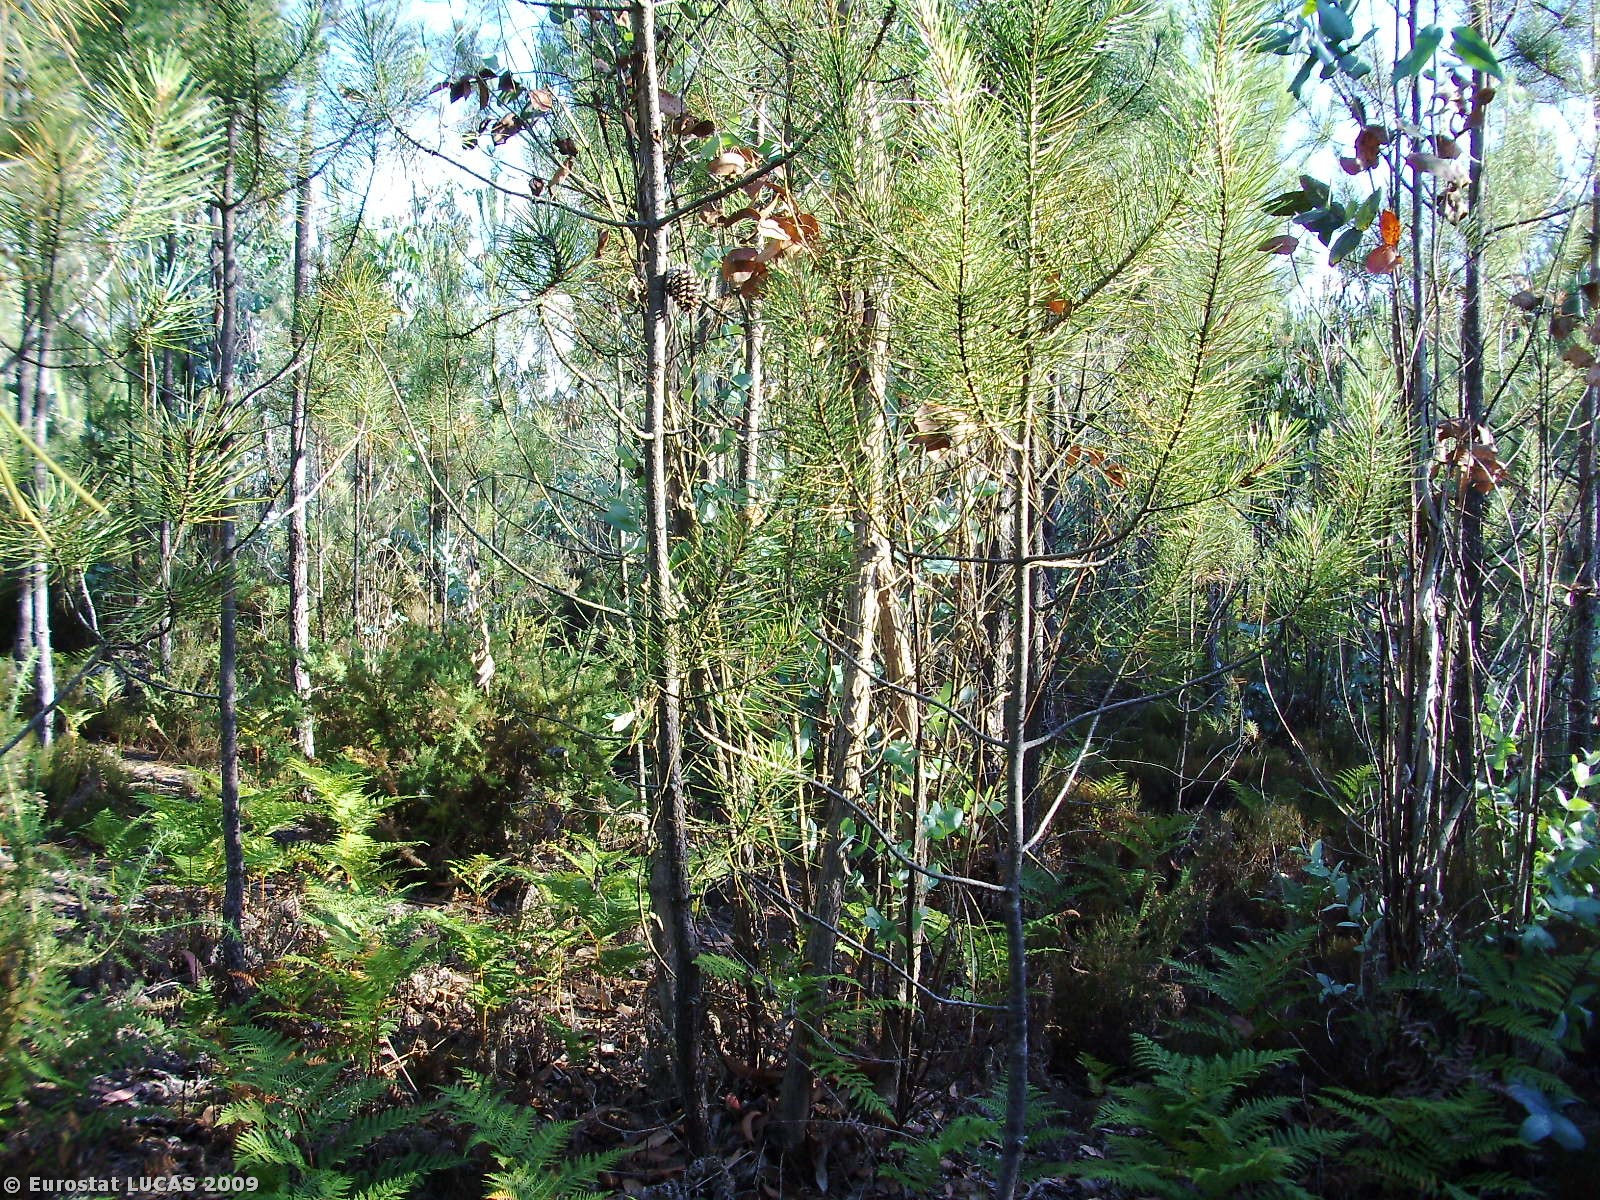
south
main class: Woodland
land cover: Coniferous woodland
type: coniferous forest of the mediterranean region
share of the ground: 50 - 75 %
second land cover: Shrubland with sparse tree cover
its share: 10 - 25 %
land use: Forestry
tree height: > 5 m
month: July
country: PT
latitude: 39.4522
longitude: -9.1606
